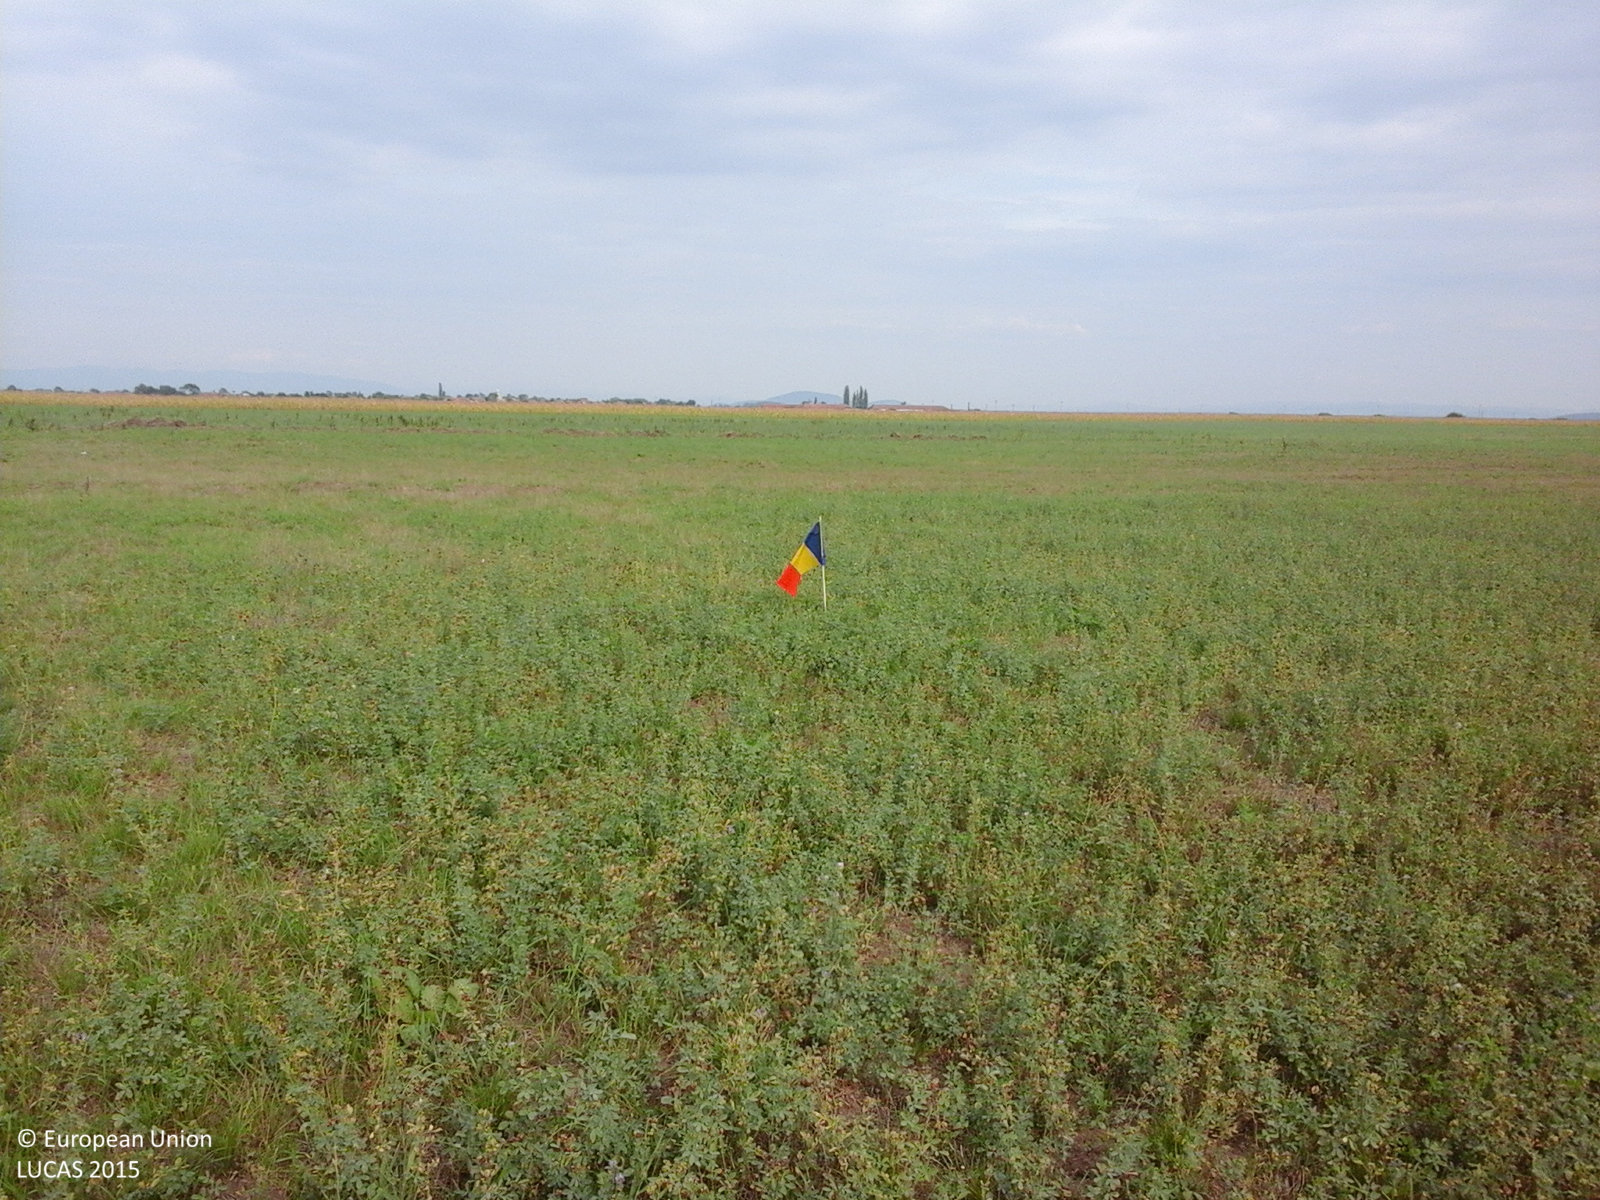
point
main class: Cropland
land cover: Lucerne
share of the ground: > 75 %
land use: Agriculture (excluding fallow land and kitchen gardens)
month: August
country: RO
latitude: 46.4113
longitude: 21.5774
